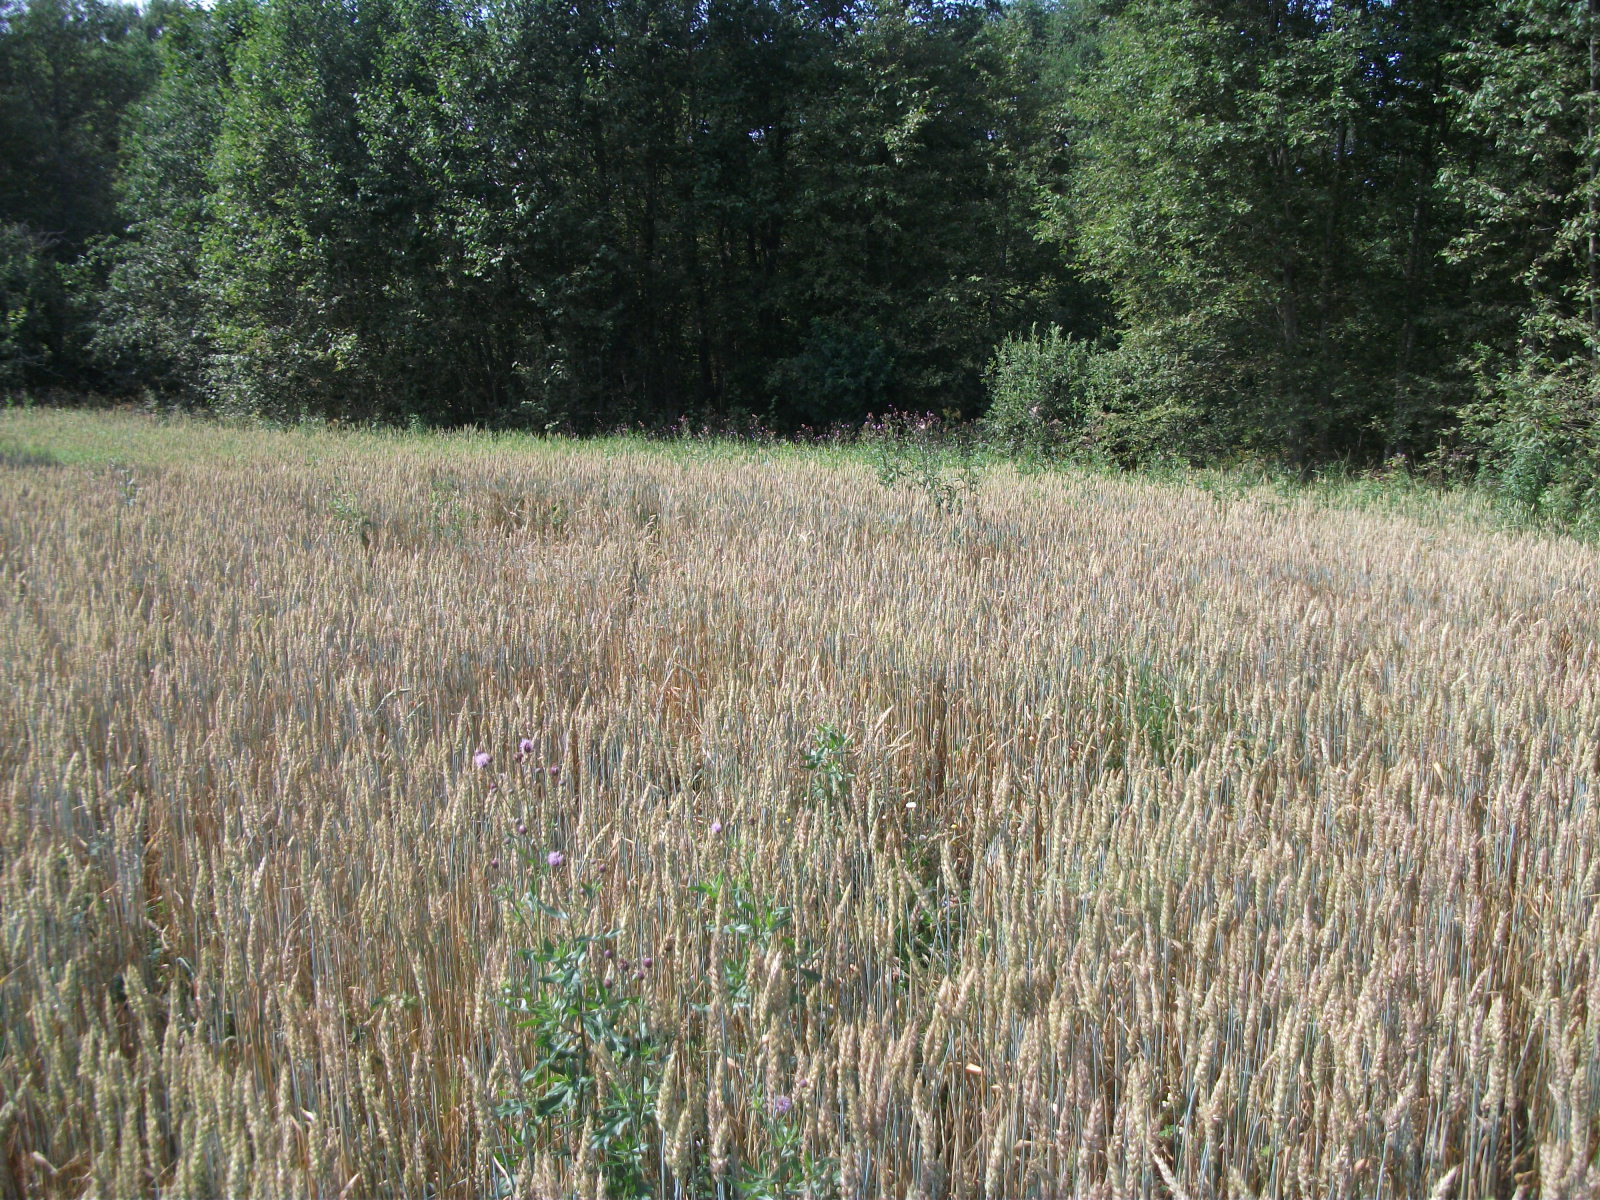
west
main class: Cropland
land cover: Common wheat
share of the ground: > 75 %
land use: Agriculture (excluding fallow land and kitchen gardens)
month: August
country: LV
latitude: 56.8348
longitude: 26.3854
